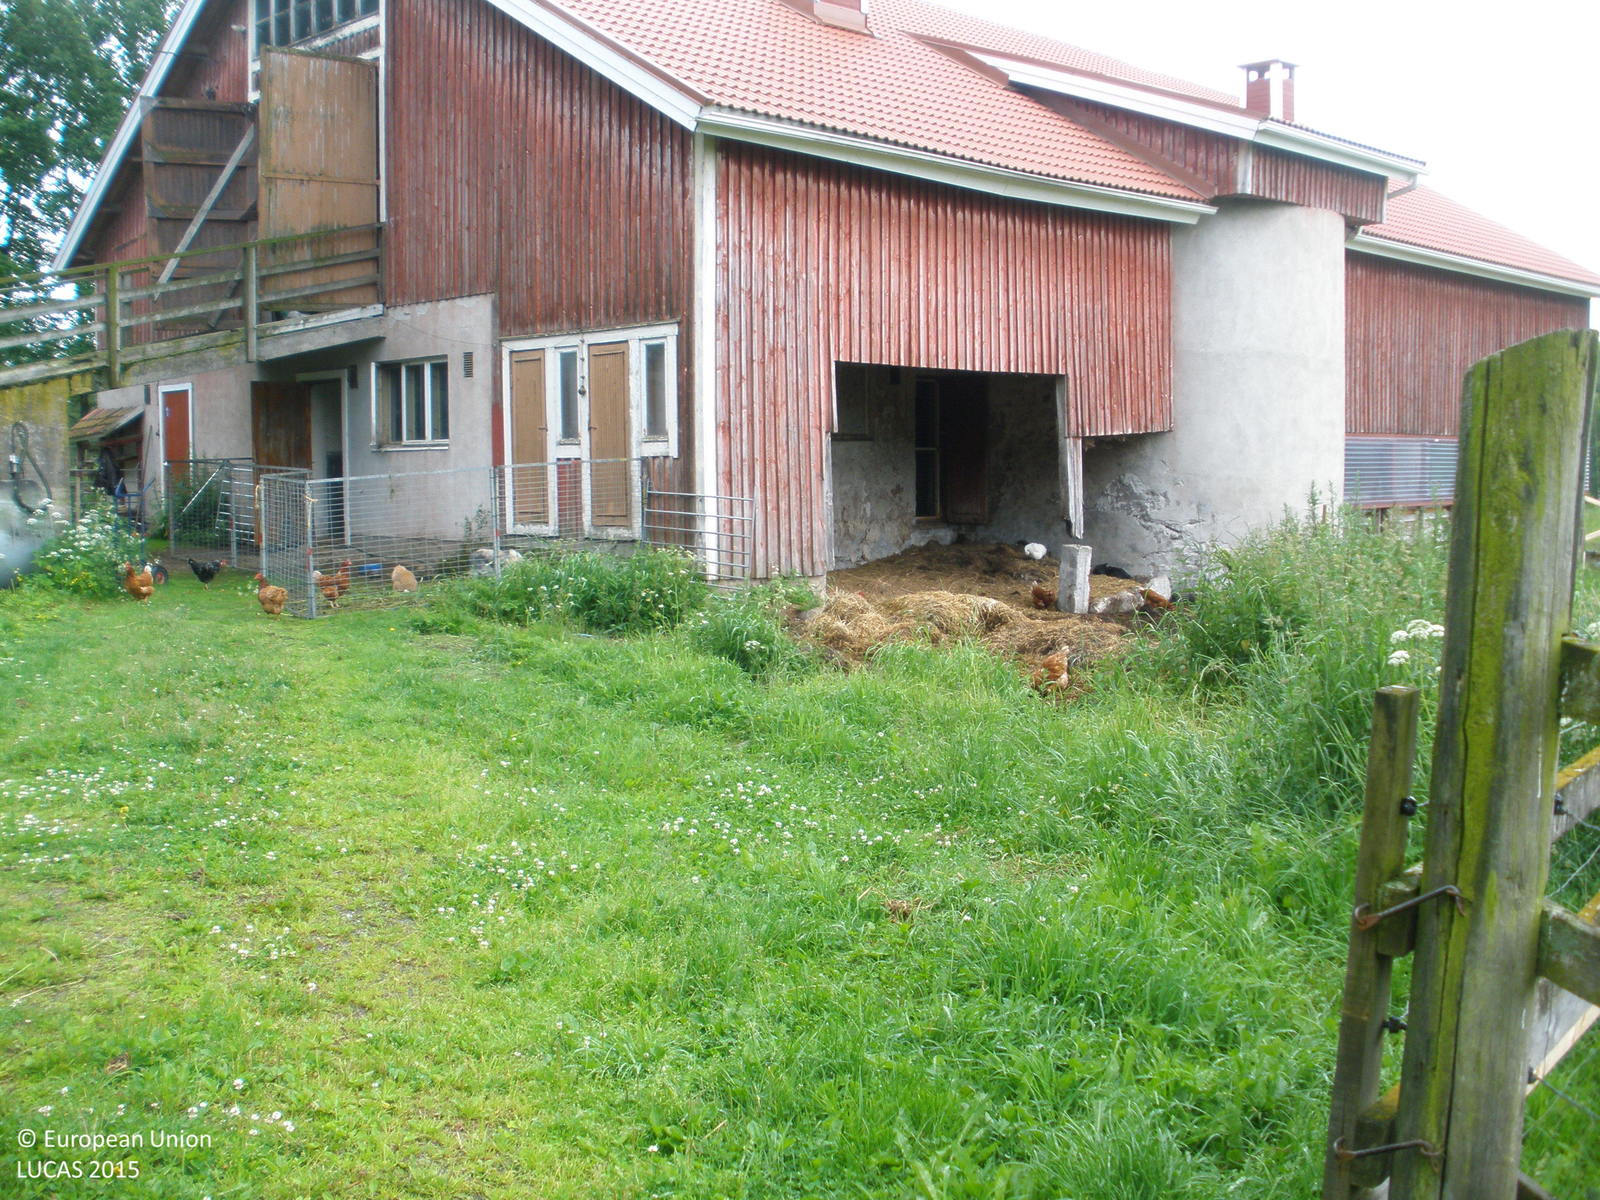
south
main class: Cropland
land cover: Temporary grasslands
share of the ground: 25 - 50 %
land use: Agriculture (excluding fallow land and kitchen gardens)
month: July
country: FI
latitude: 61.4190
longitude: 23.2485
